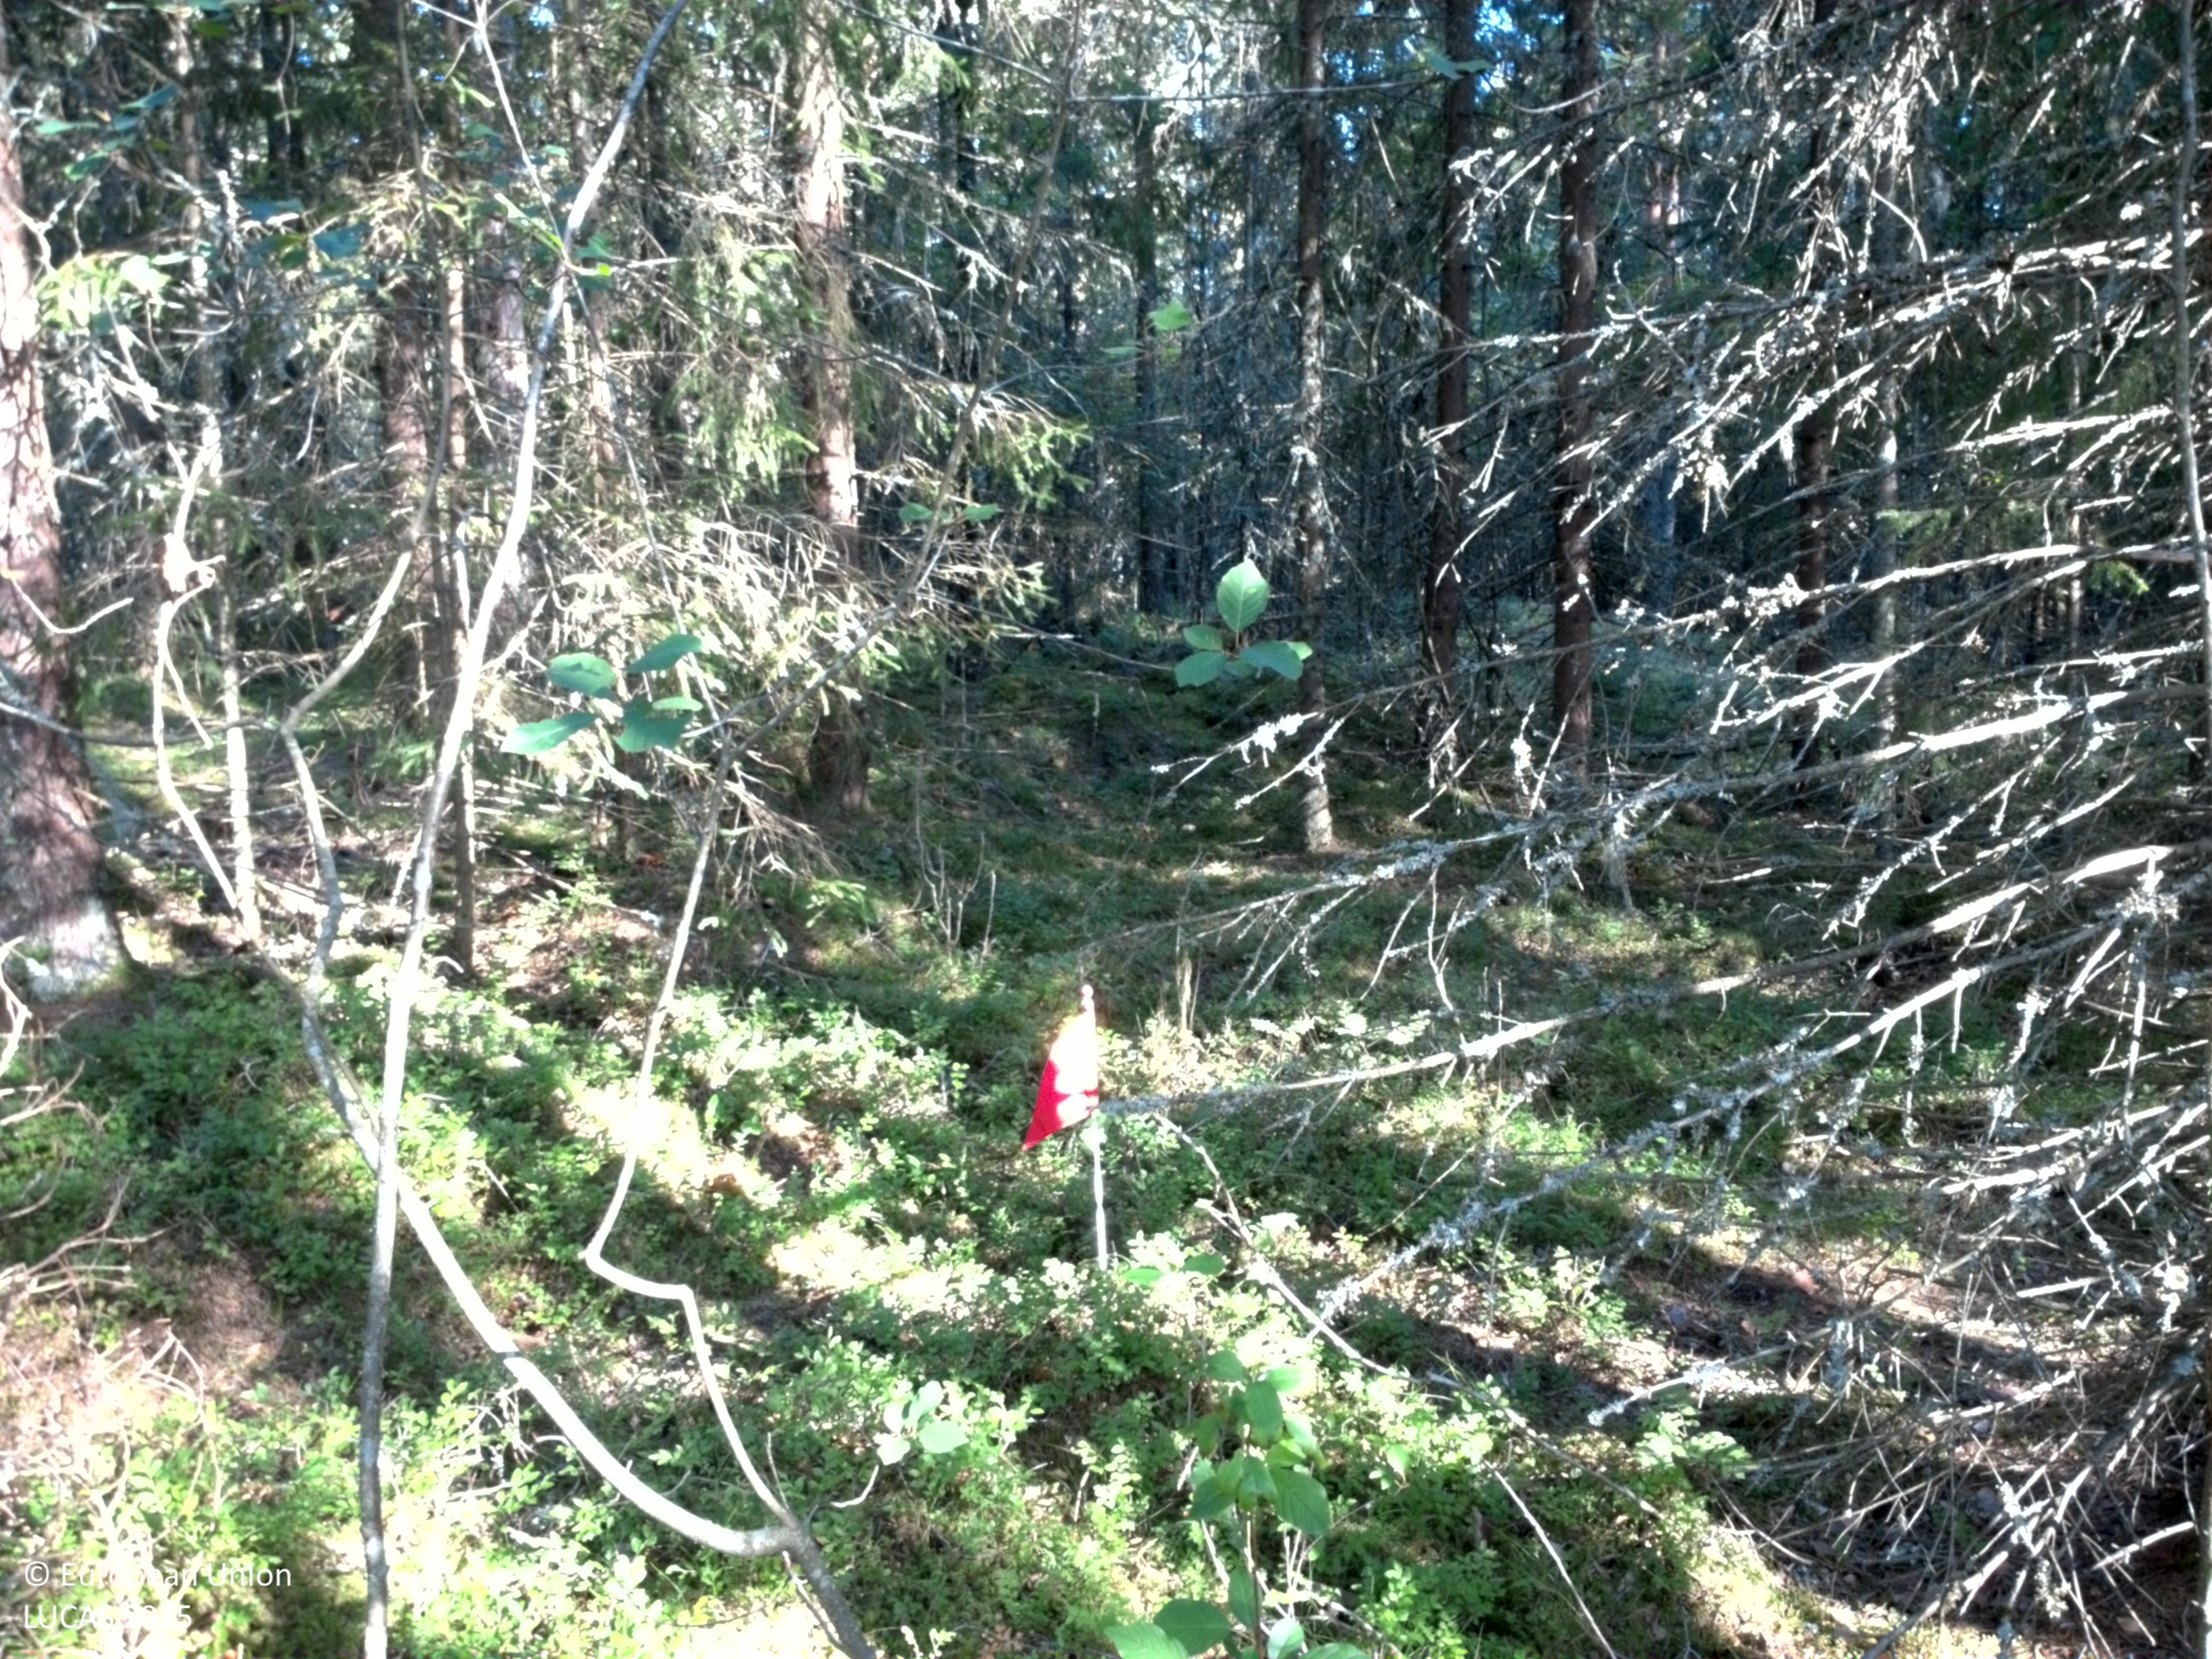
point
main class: Woodland
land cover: Spruce dominated coniferous woodland
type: boreal forest
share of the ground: 50 - 75 %
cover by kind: coniferous forest trees 60 %, lichens and mosses 20 %, shrubs 15 %, broadleaved forest trees 5 %
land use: Forestry
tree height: > 5 m
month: August
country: SE
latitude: 59.5099
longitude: 13.3669
